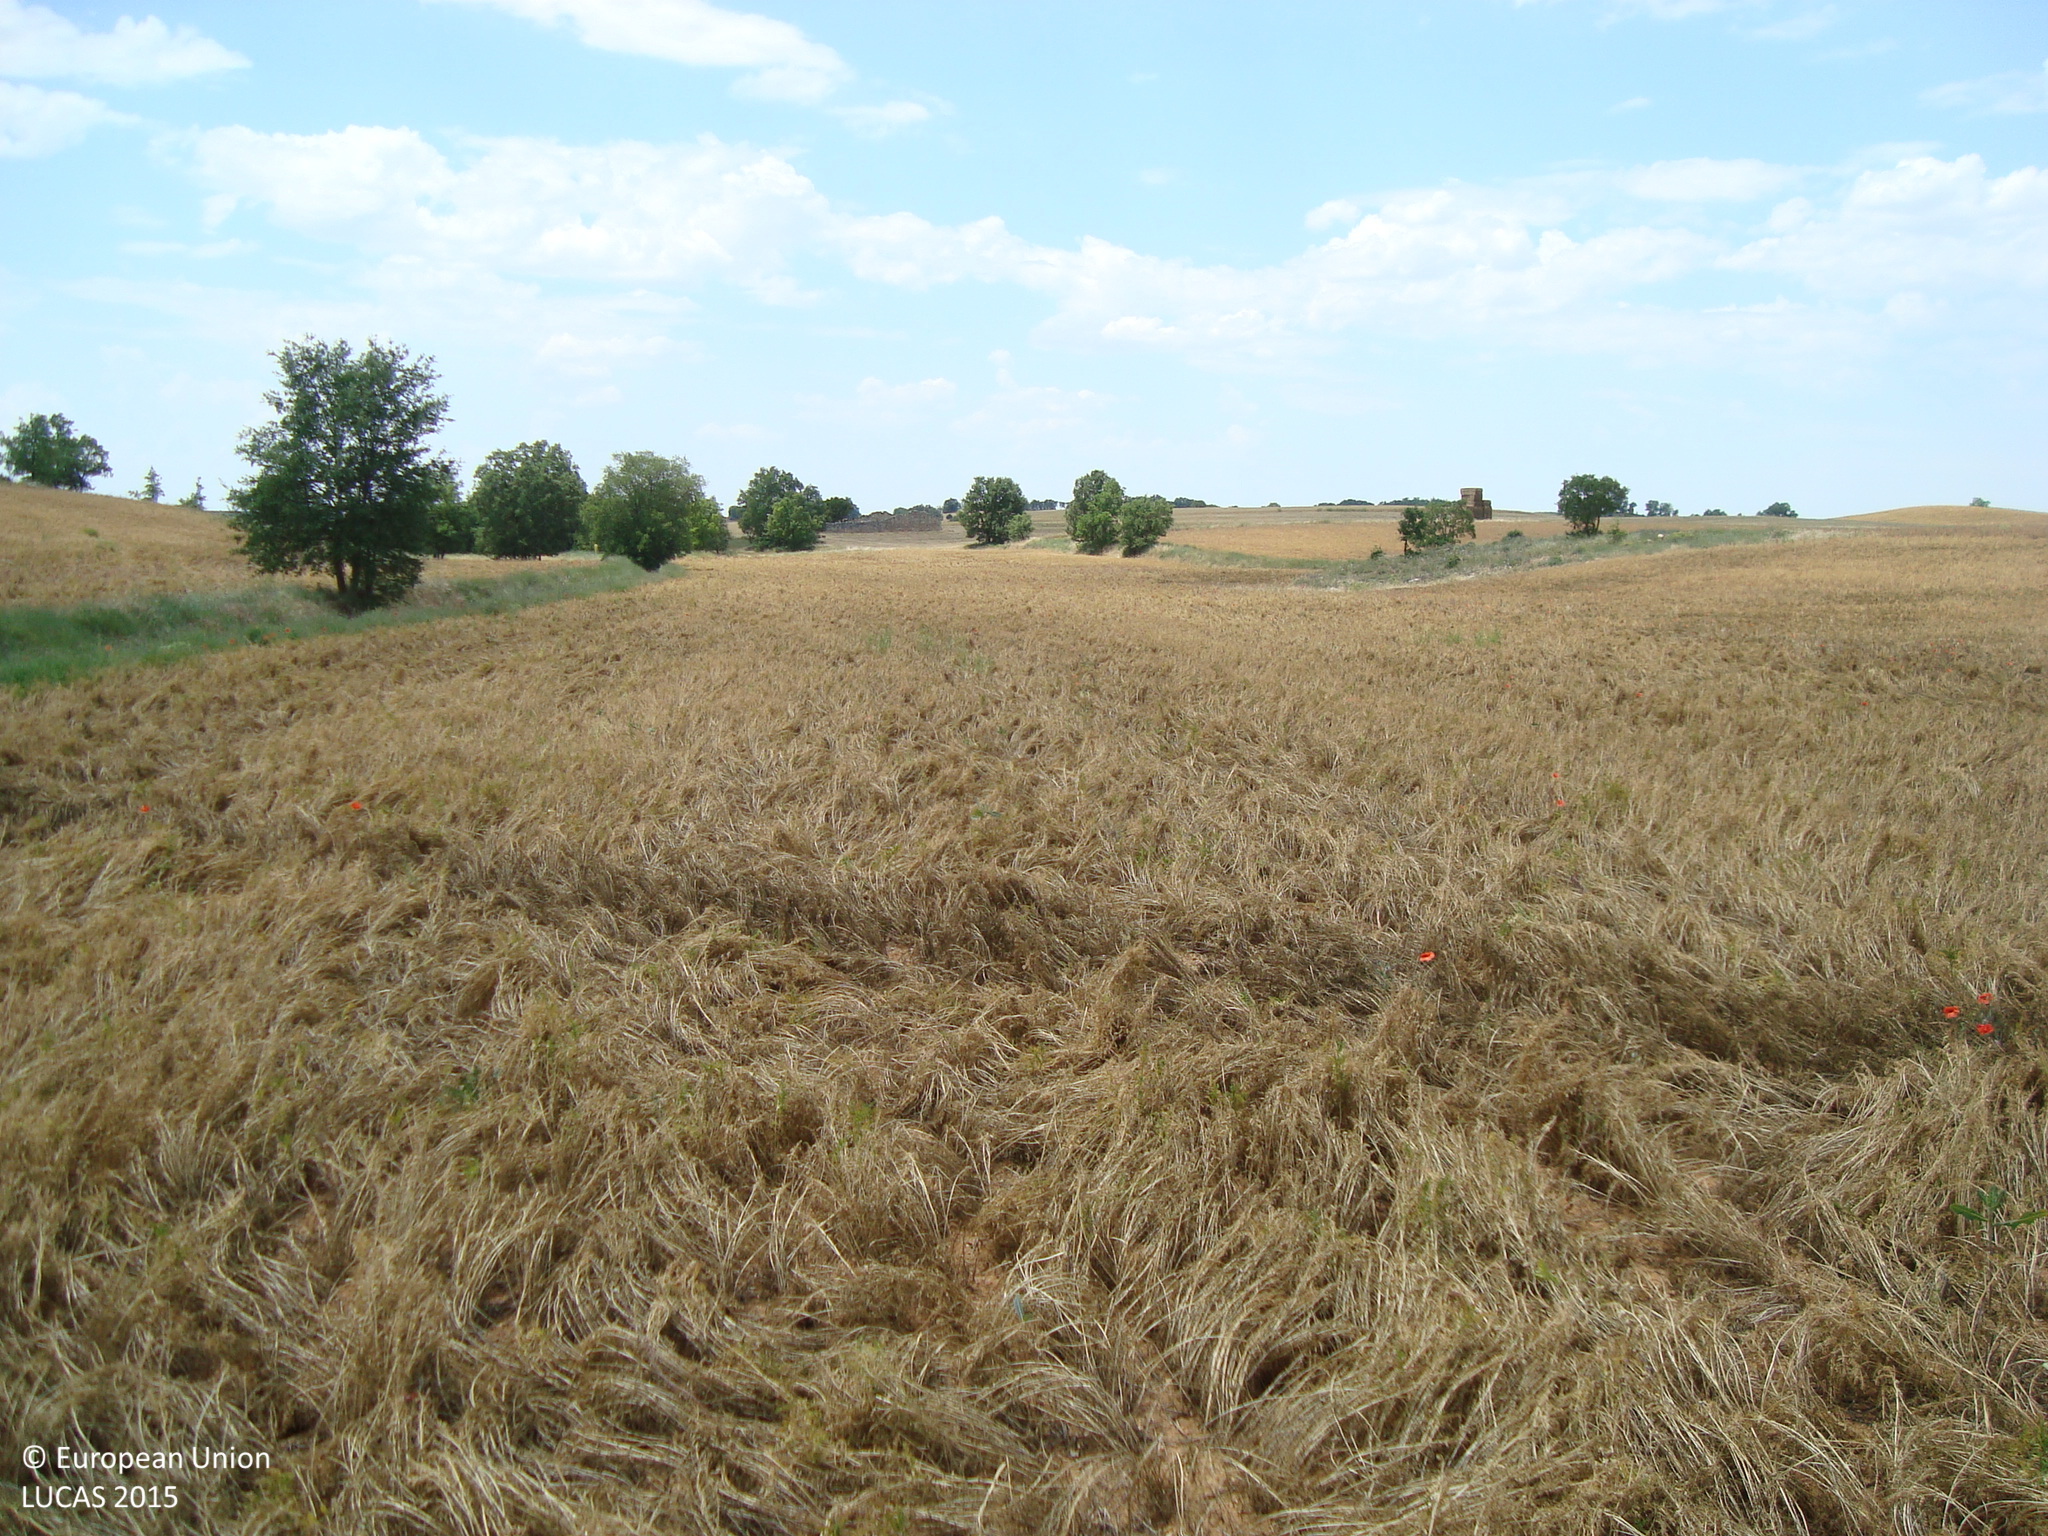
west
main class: Cropland
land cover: Dry pulses
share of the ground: > 75 %
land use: Agriculture (excluding fallow land and kitchen gardens)
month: June
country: ES
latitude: 41.8834
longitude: -3.5623
